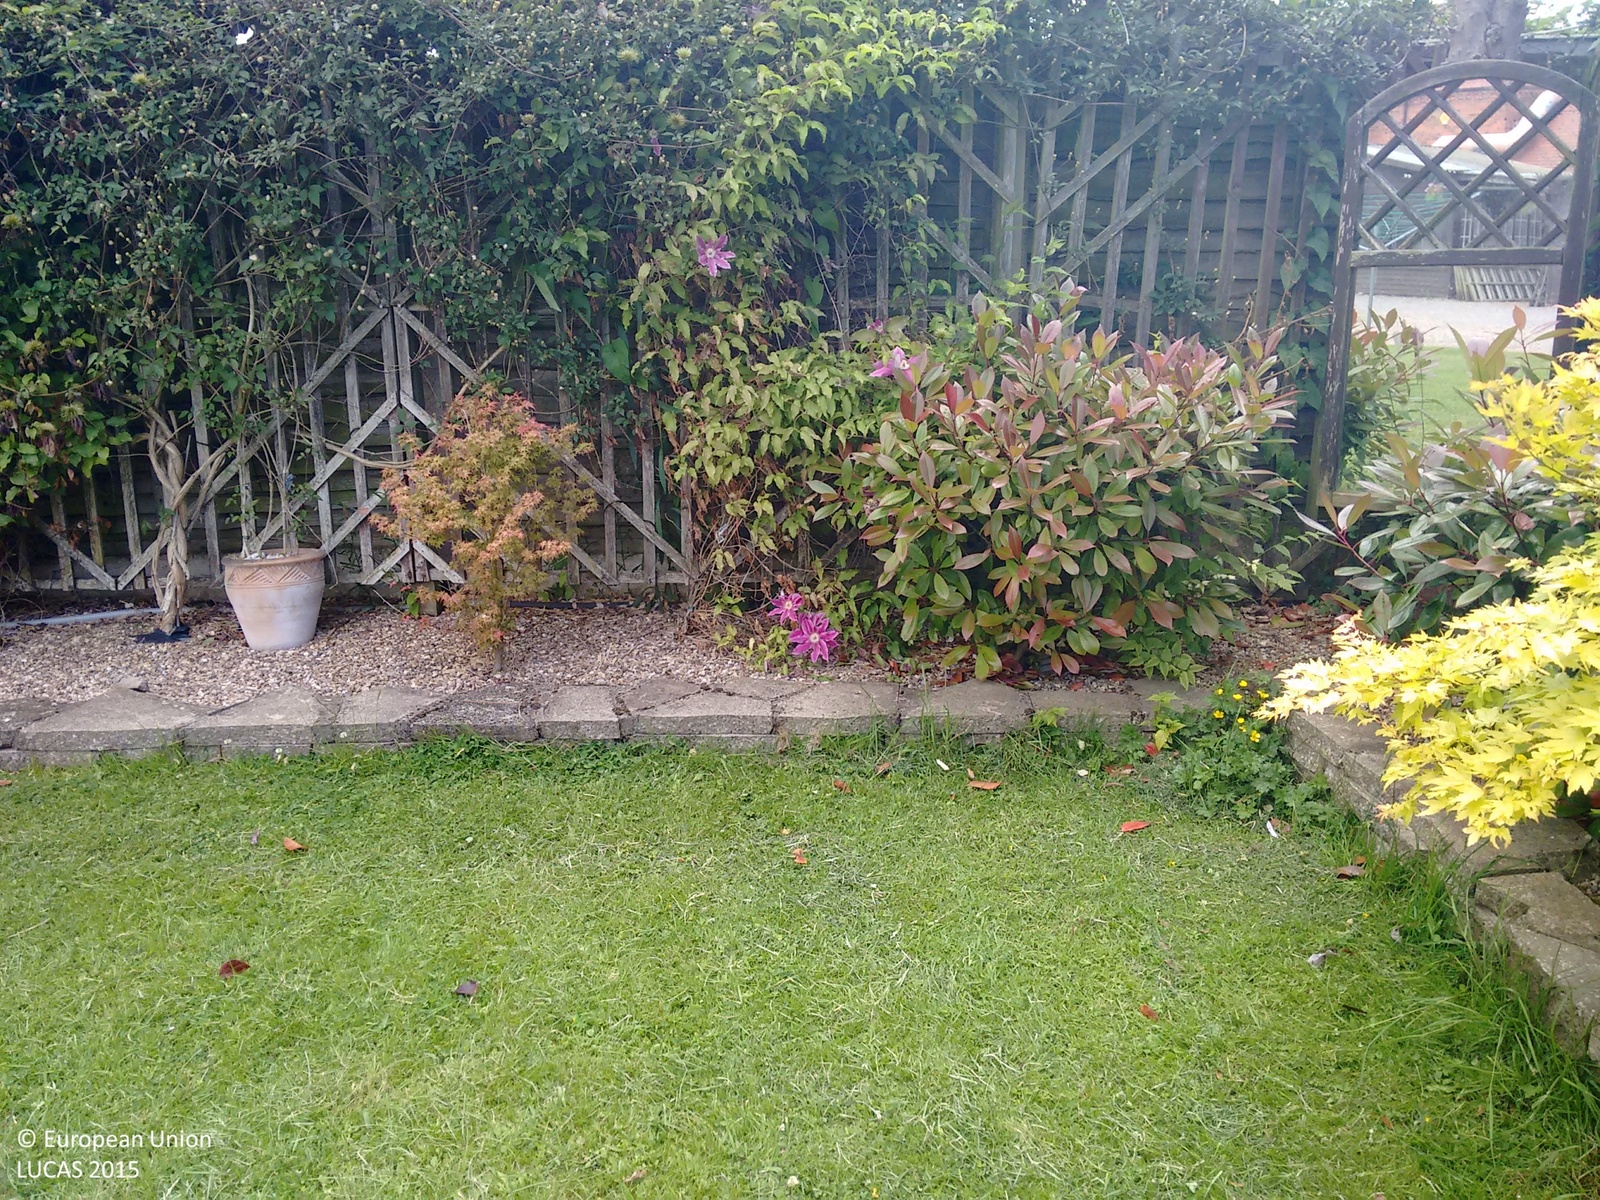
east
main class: Grassland
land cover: Grassland with sparse tree/shrub cover
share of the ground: > 75 %
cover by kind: herbaceous plants 90 %, broadleaved forest trees 5 %, shrubs 5 %
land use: Residential
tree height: < 5 m
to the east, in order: Grassland with sparse tree/shrub cover; Artificial constructions in urban areas; Spontaneously vegetated surfaces; Artificial constructions in urban areas; Abandoned hedges; Tracks; Abandoned hedges
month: June
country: GB
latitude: 52.2394
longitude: -2.1718
